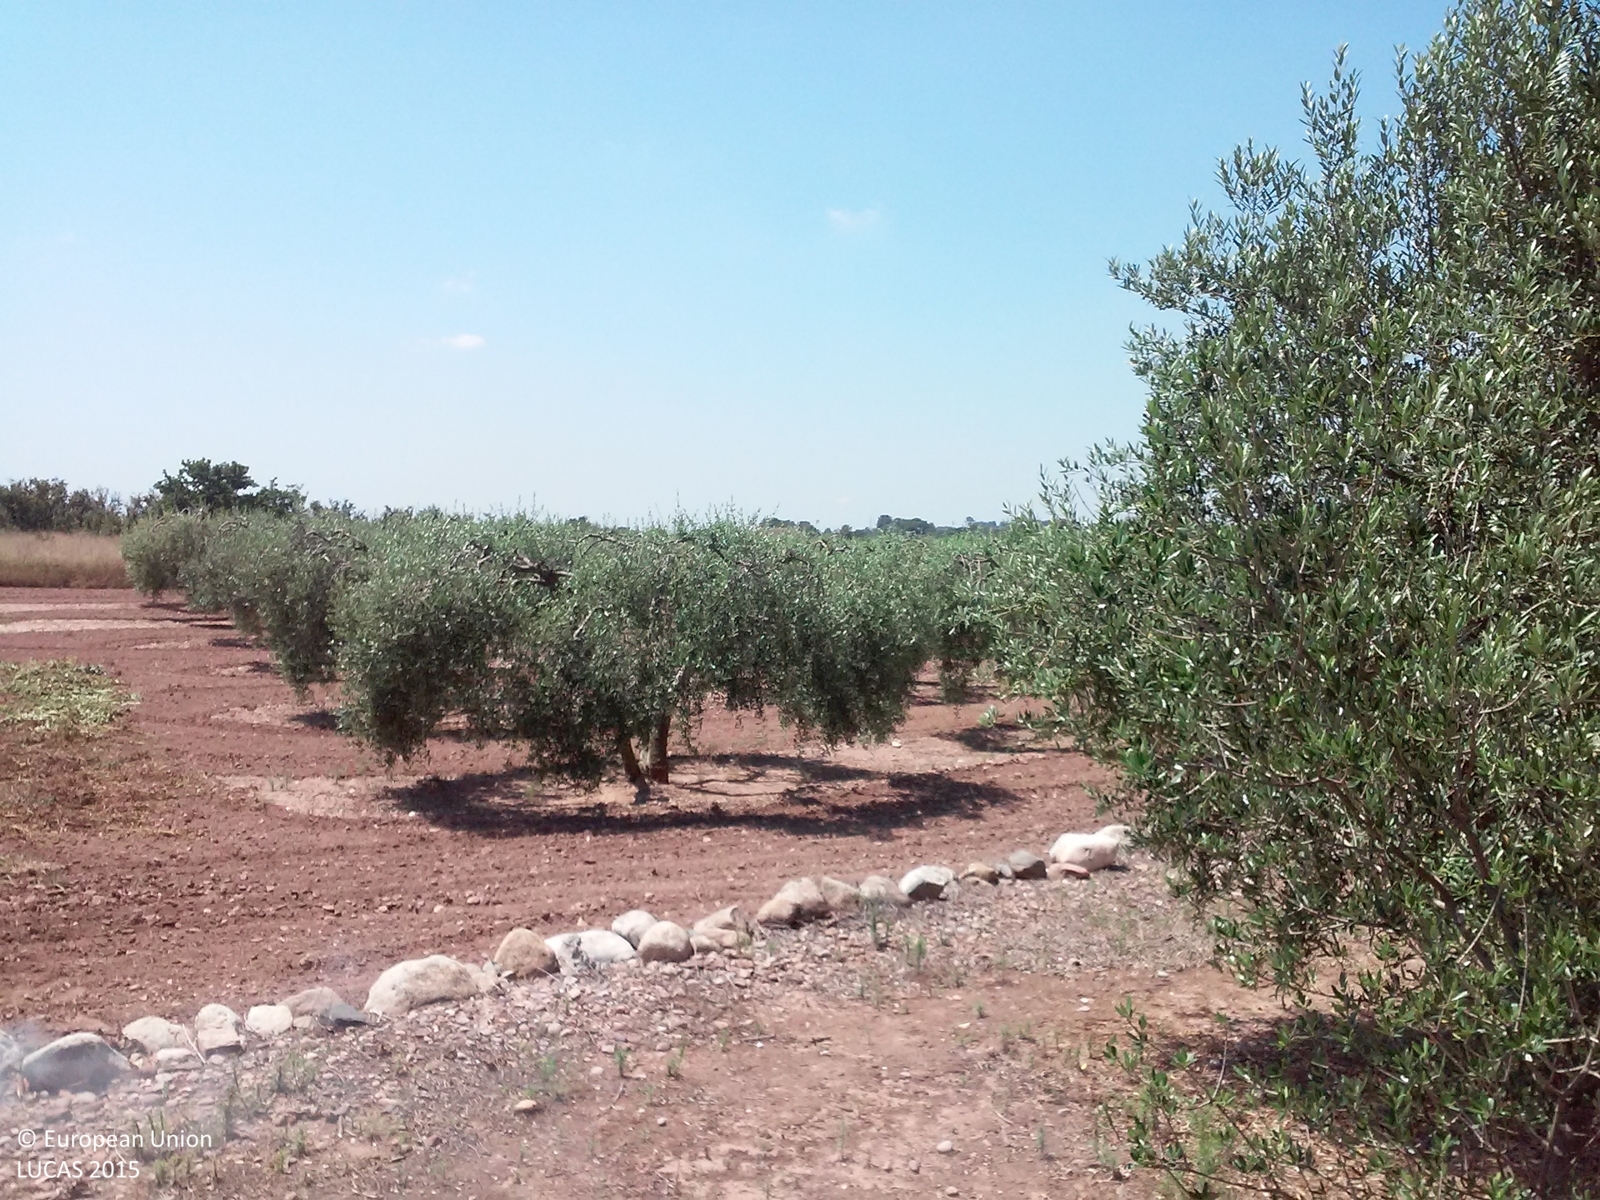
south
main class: Cropland
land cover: Olive groves
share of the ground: 25 - 50 %
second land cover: Other bare soil
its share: > 75 %
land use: Agriculture (excluding fallow land and kitchen gardens)
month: June
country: ES
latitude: 41.2550
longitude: 1.2209
